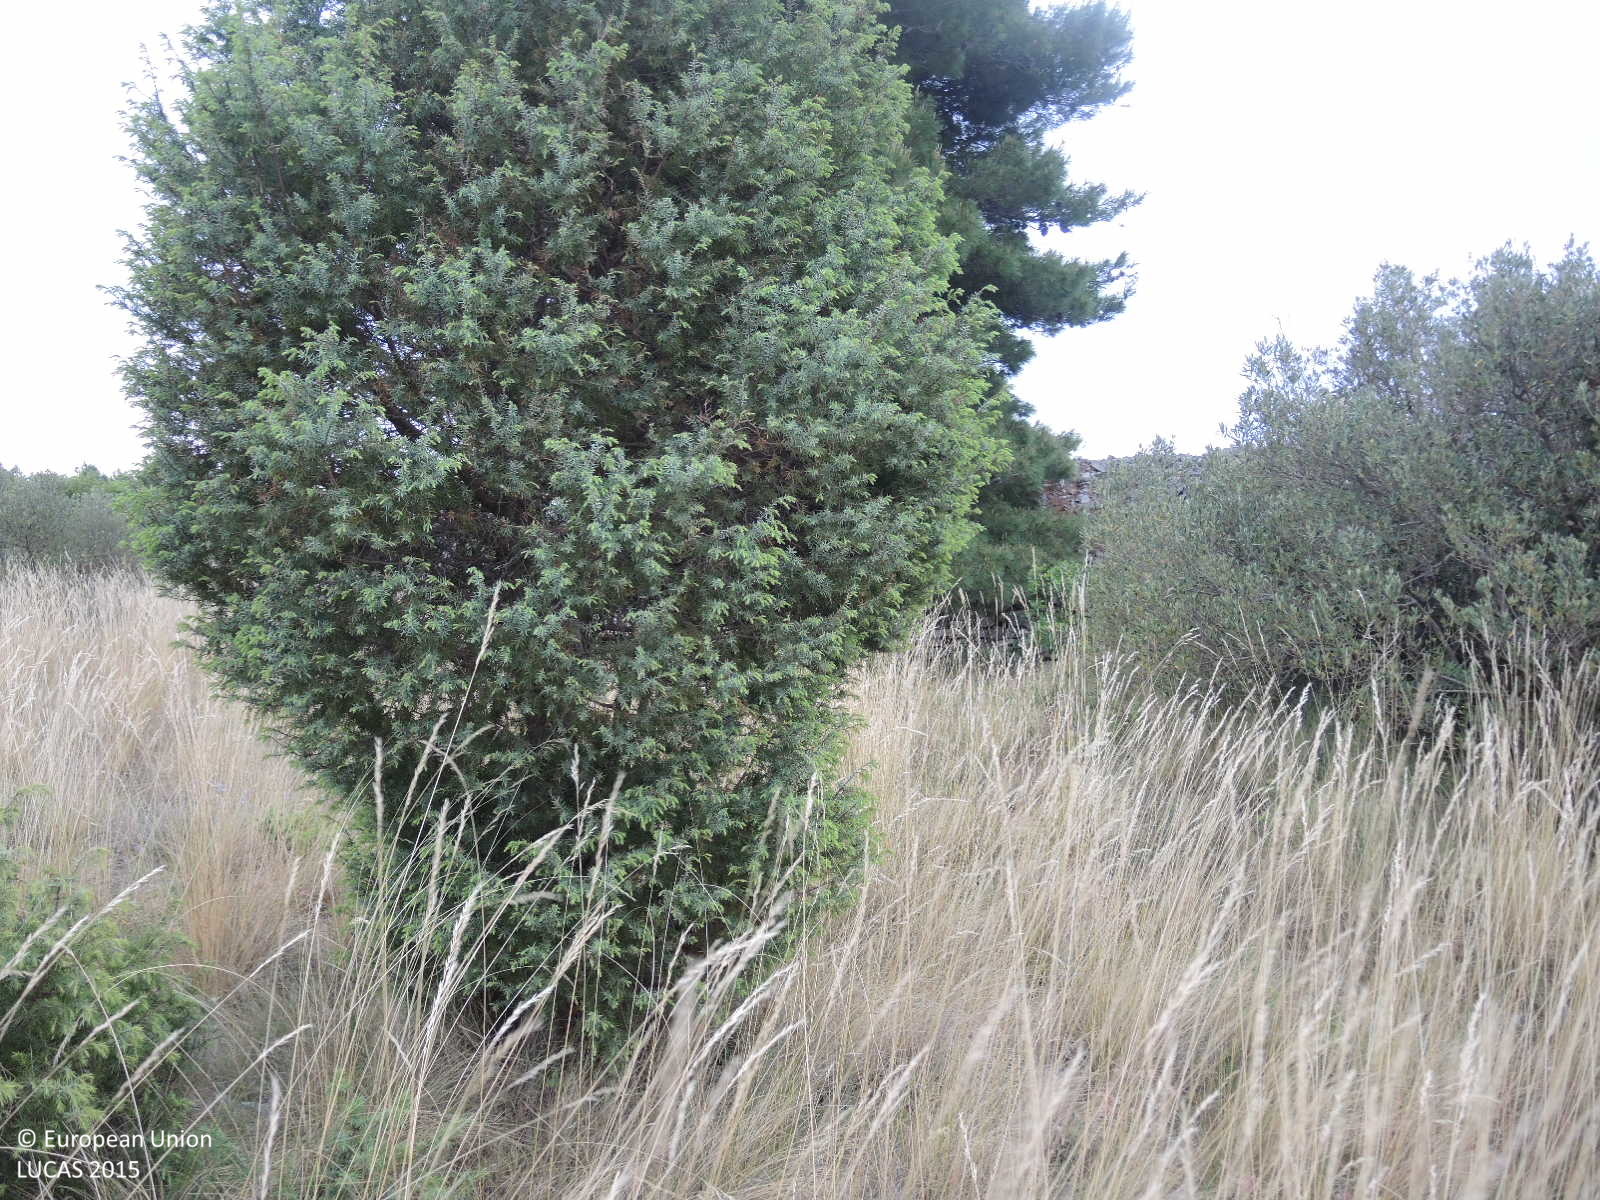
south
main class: Cropland
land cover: Olive groves
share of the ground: 10 - 25 %
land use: Agriculture (excluding fallow land and kitchen gardens)
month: May
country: HR
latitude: 43.7535
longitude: 15.8158
